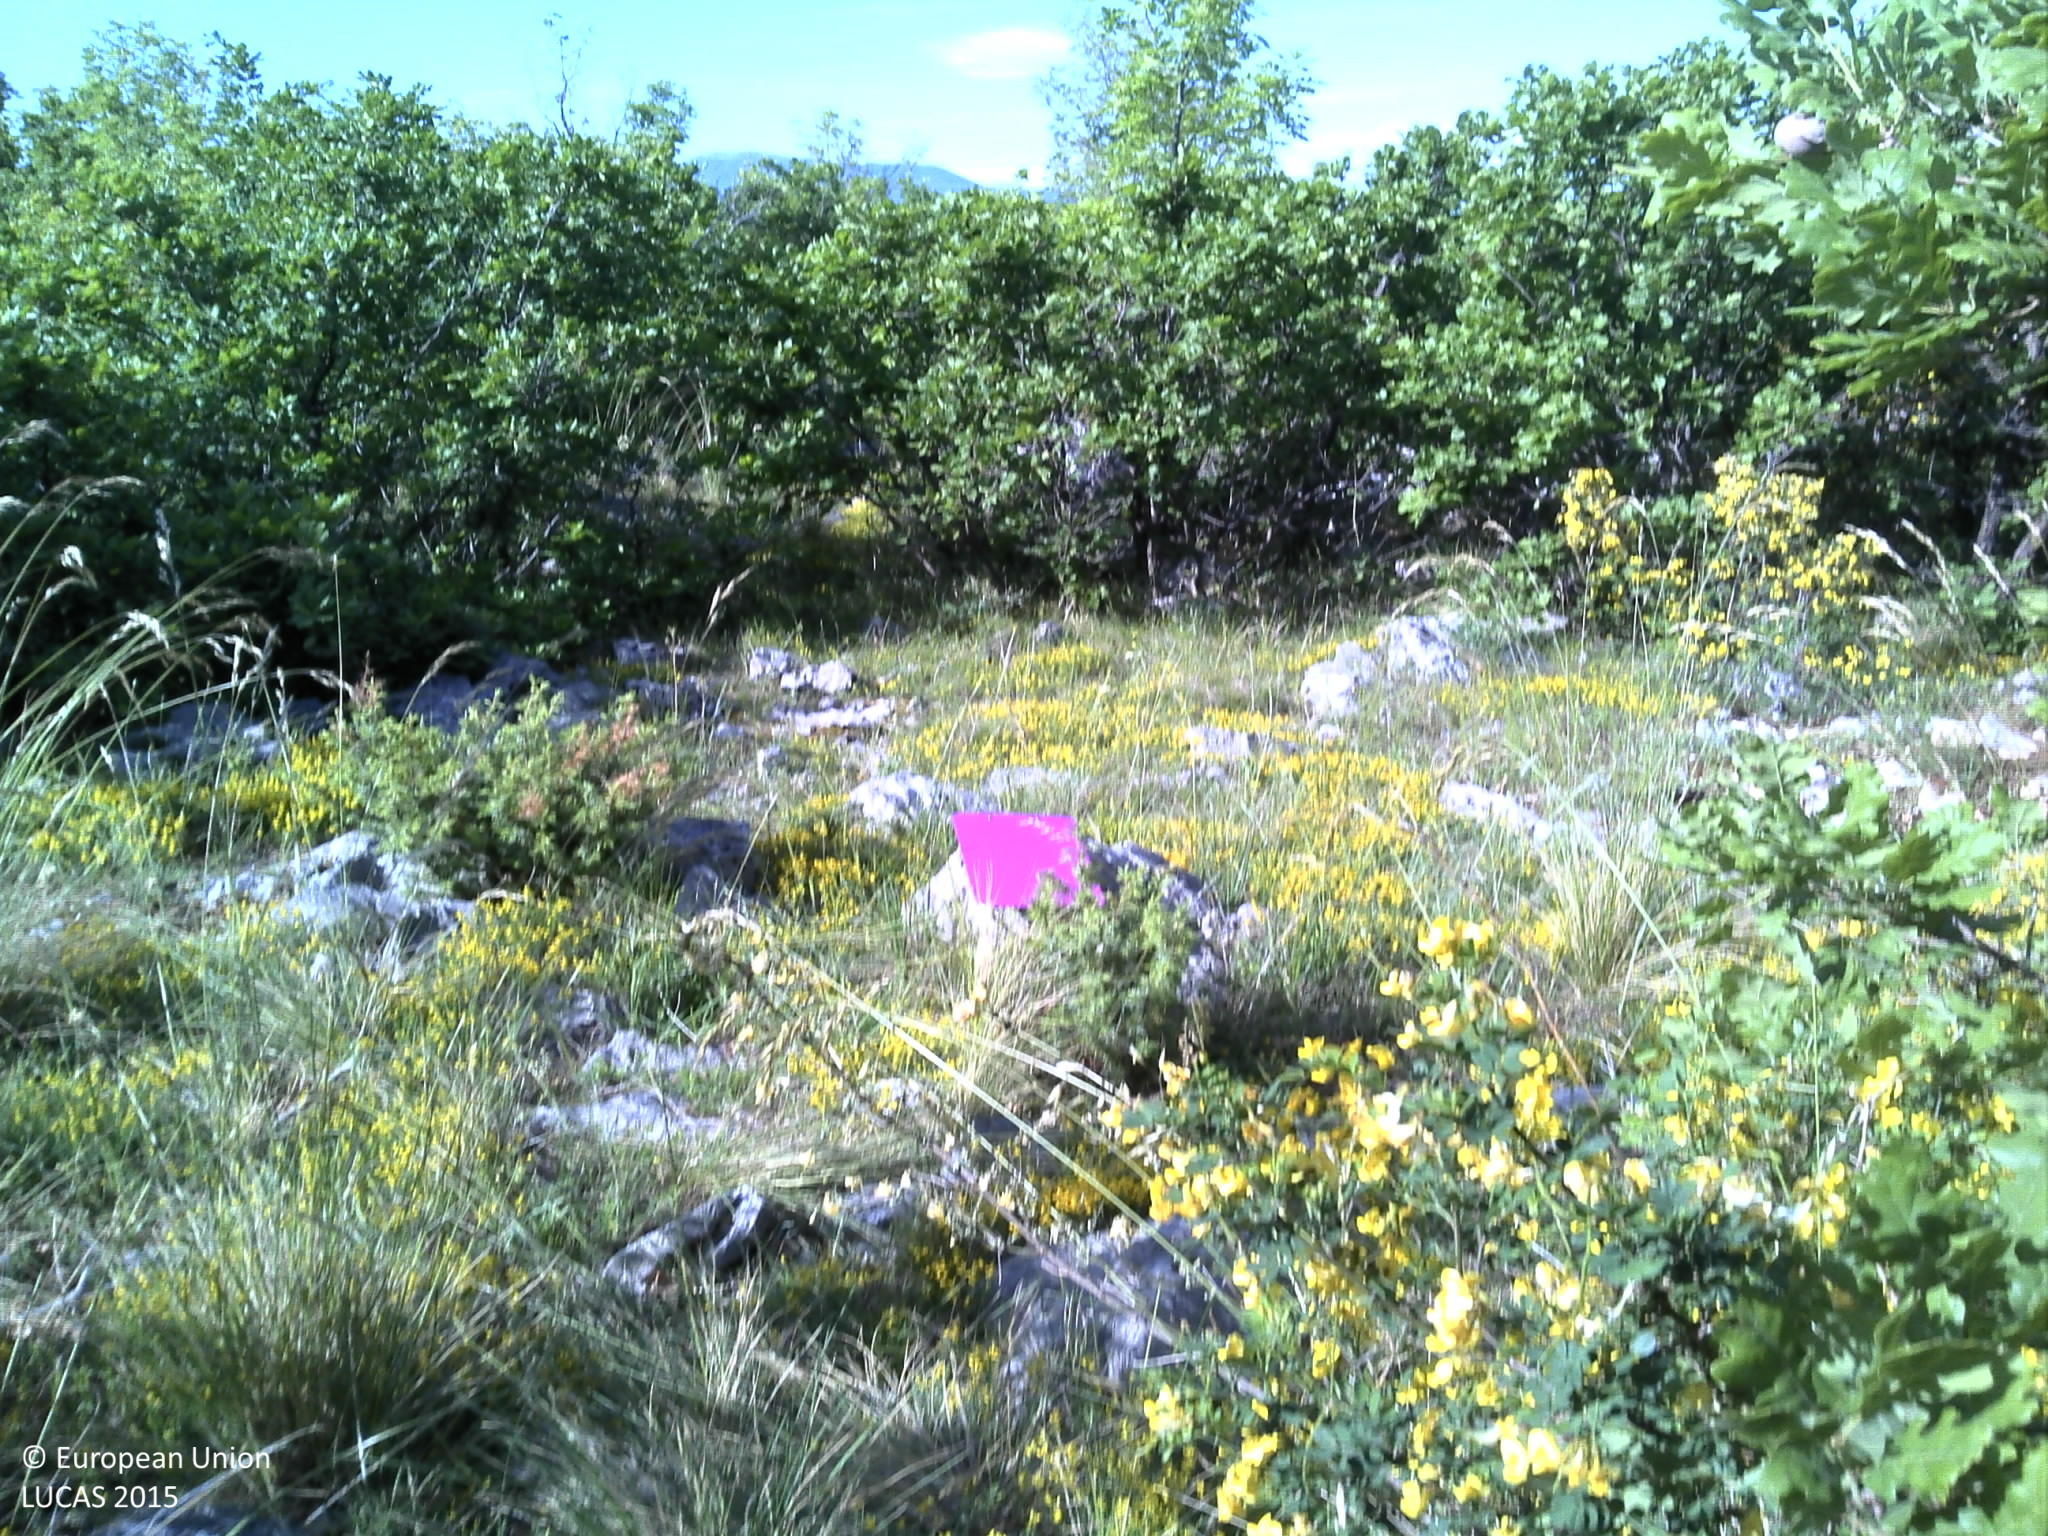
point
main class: Woodland
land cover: Broadleaved woodland
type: thermophilous deciduous forest
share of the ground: 50 - 75 %
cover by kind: shrubs 40 %, broadleaved forest trees 35 %, herbaceous plants 10 %, unconsolidated bare surface 10 %, consolidated bare surface 5 %
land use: Semi-natural and natural areas not in use
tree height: > 5 m
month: May
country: HR
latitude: 44.0538
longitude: 16.2462
